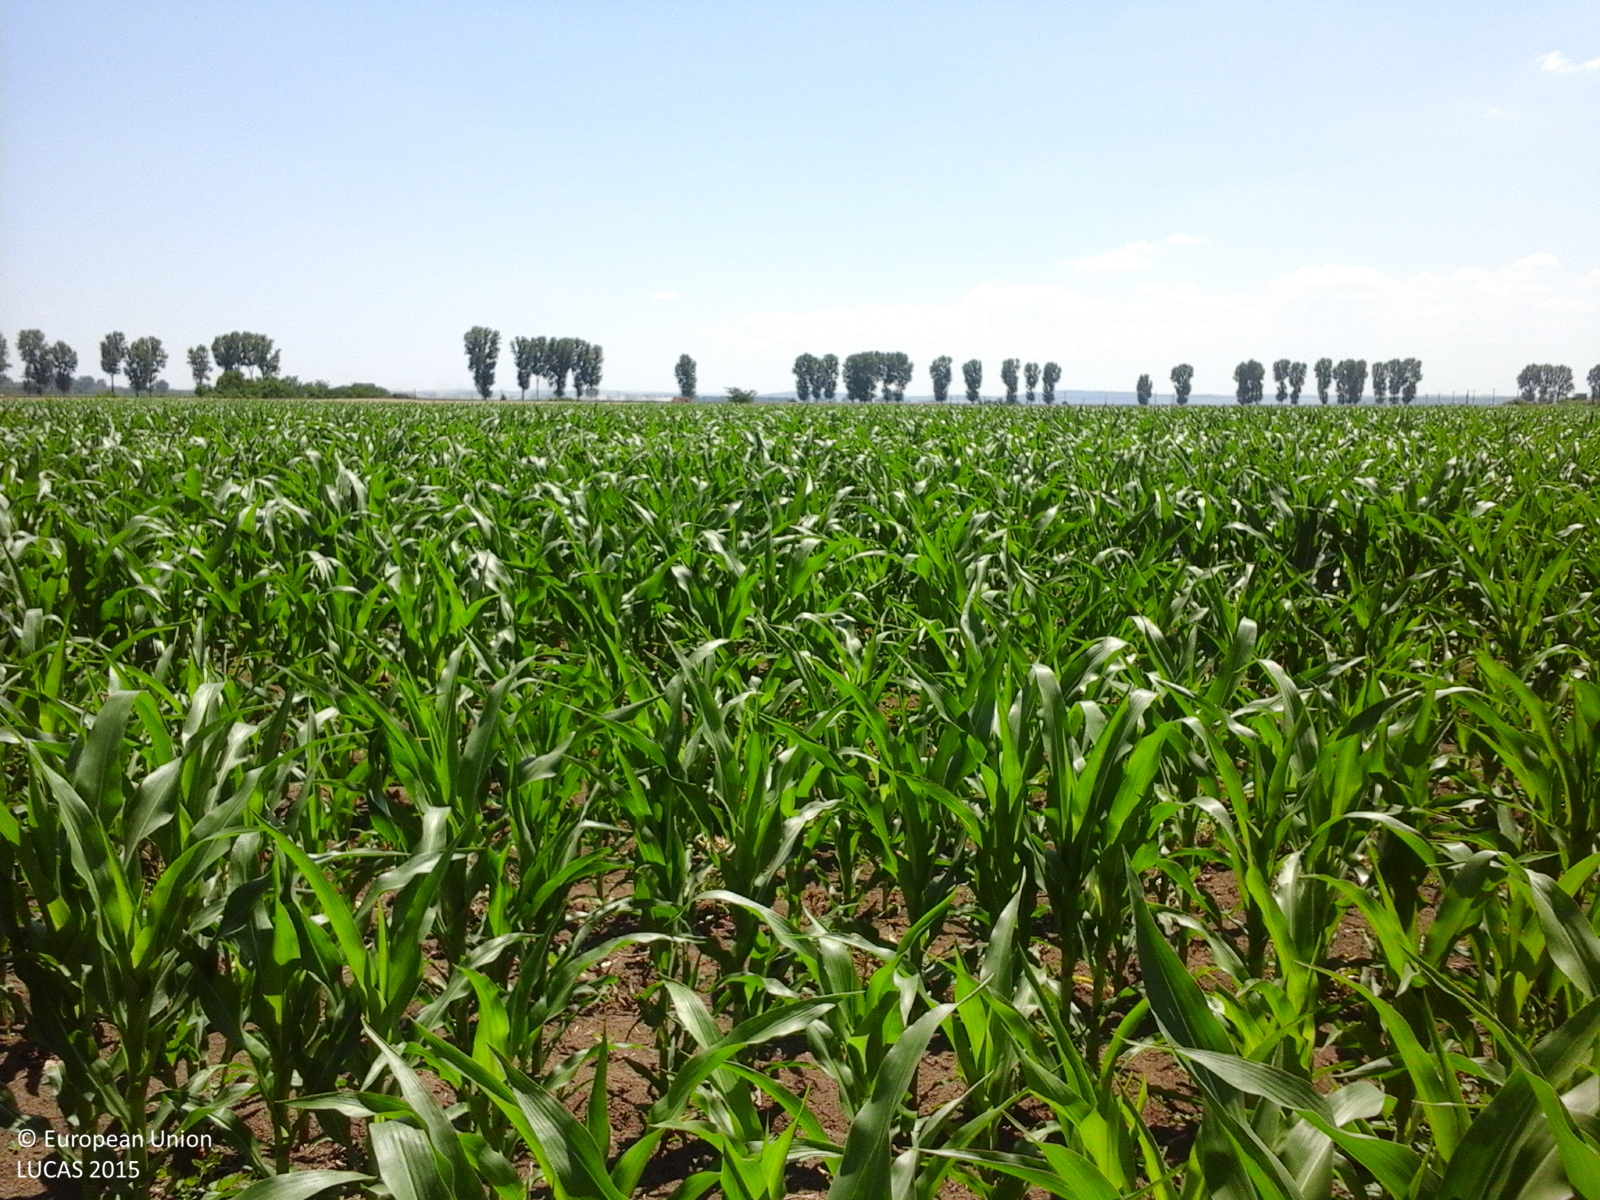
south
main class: Cropland
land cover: Maize
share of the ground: 50 - 75 %
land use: Agriculture (excluding fallow land and kitchen gardens)
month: June
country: RO
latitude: 47.4481
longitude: 27.5321
